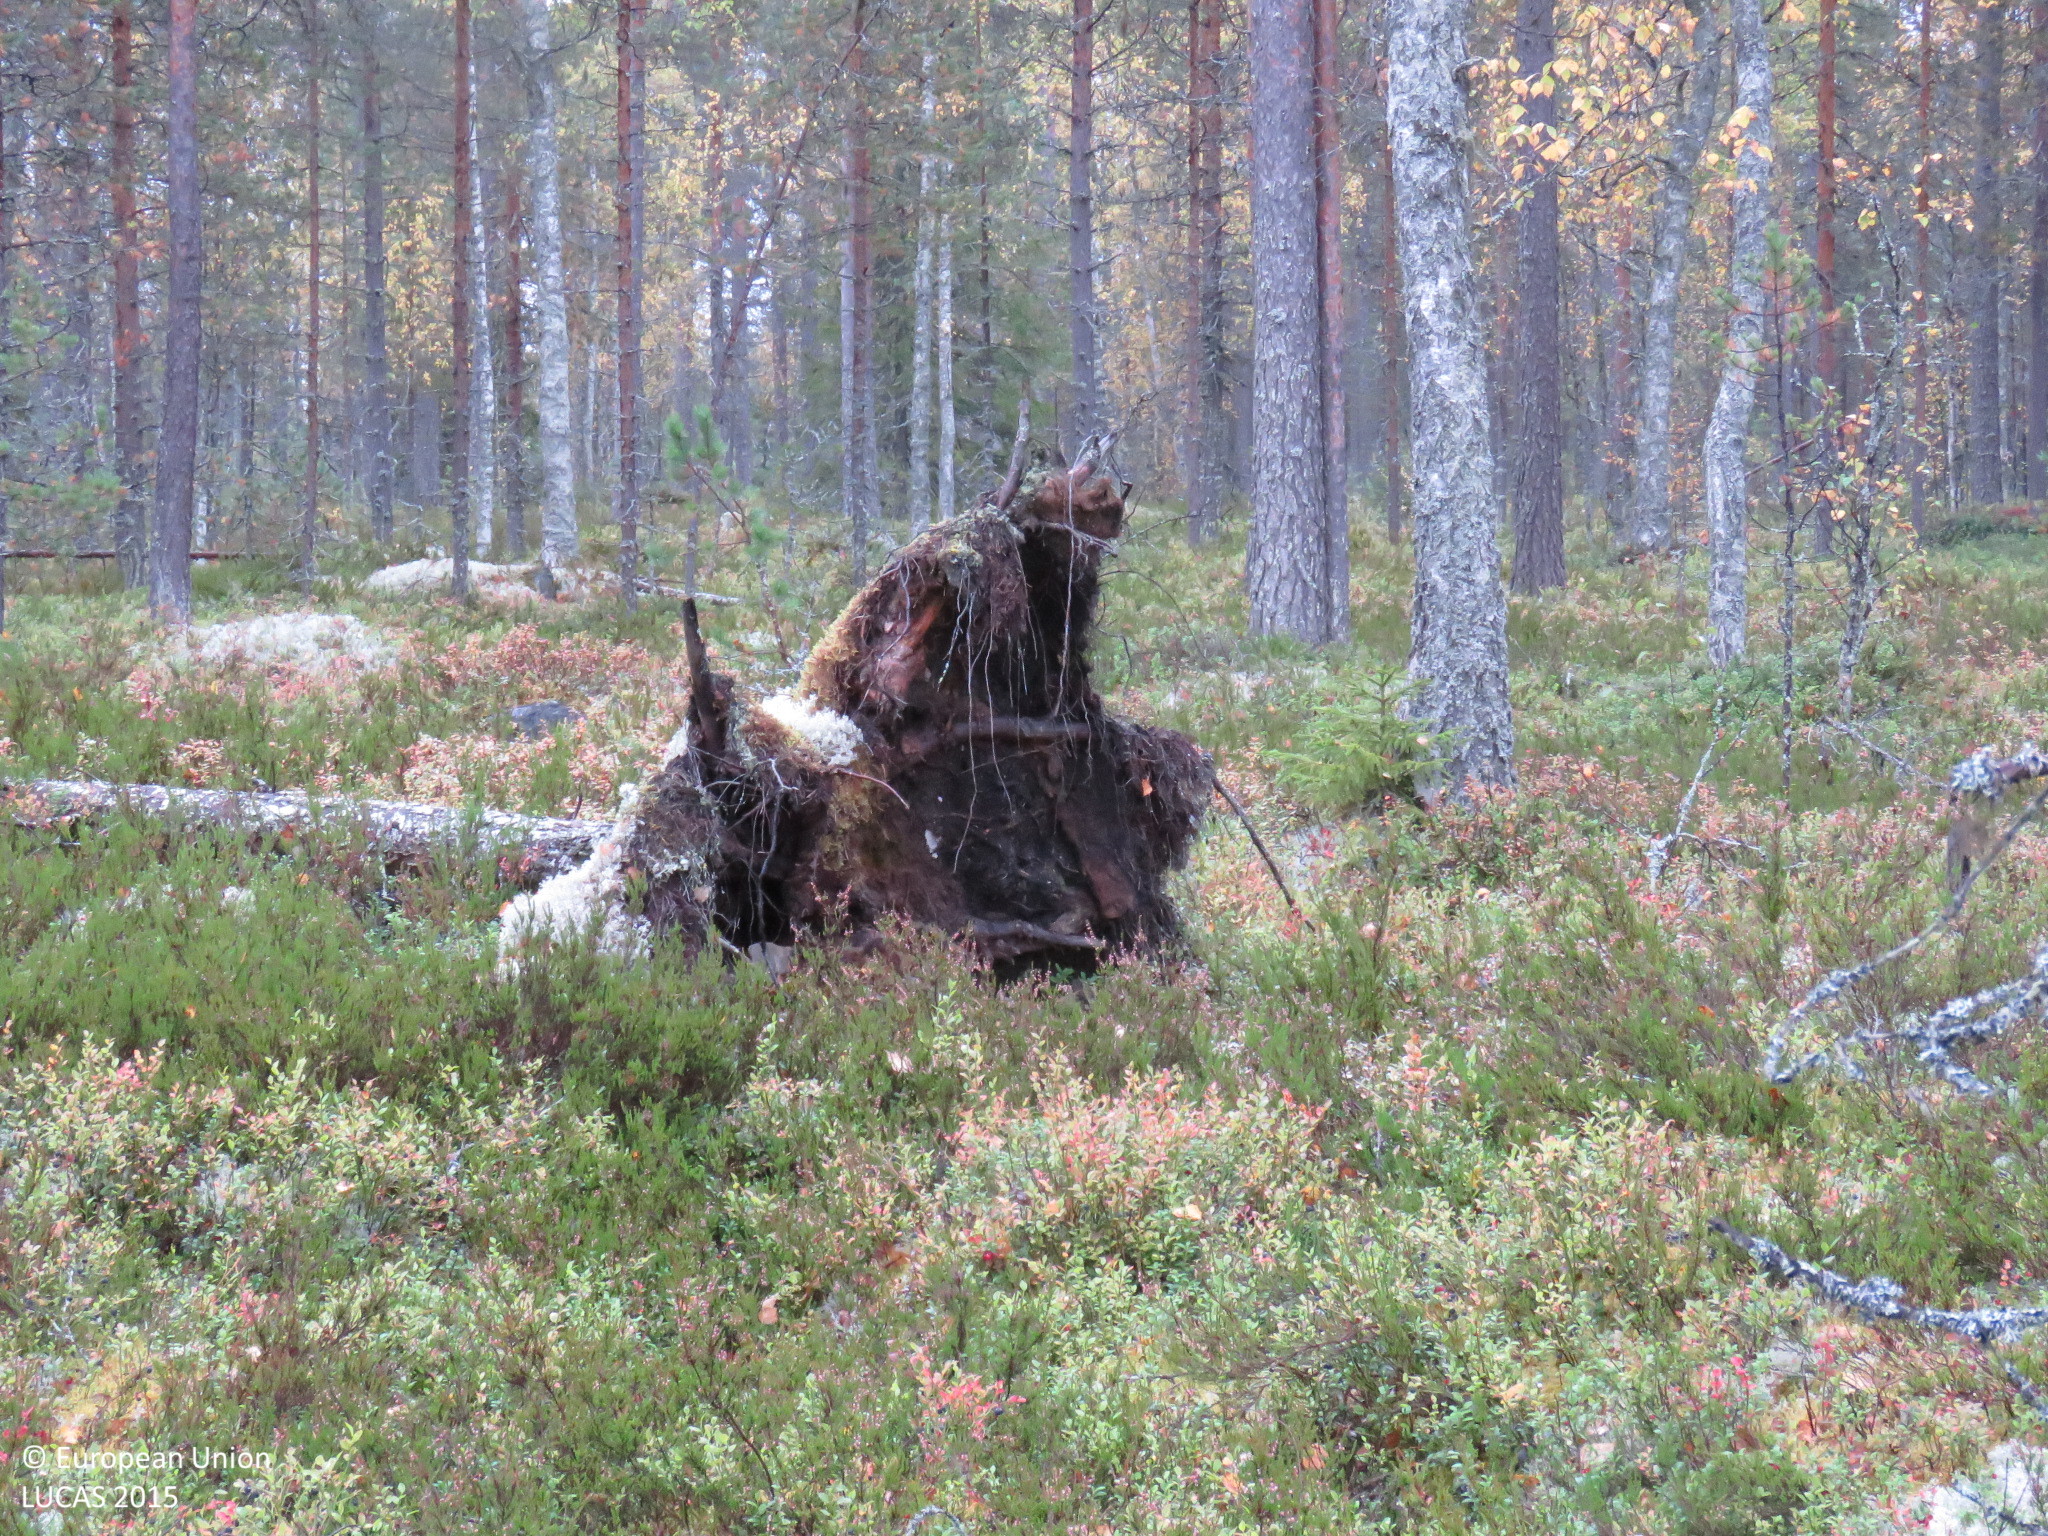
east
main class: Woodland
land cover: Other mixed woodland
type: boreal forest
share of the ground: 50 - 75 %
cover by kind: coniferous forest trees 45 %, broadleaved forest trees 25 %, shrubs 20 %, lichens and mosses 10 %
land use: Forestry
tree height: > 5 m
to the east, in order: Other mixed woodland; Pine dominated coniferous woodland
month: September
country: FI
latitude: 64.7960
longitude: 26.9387
